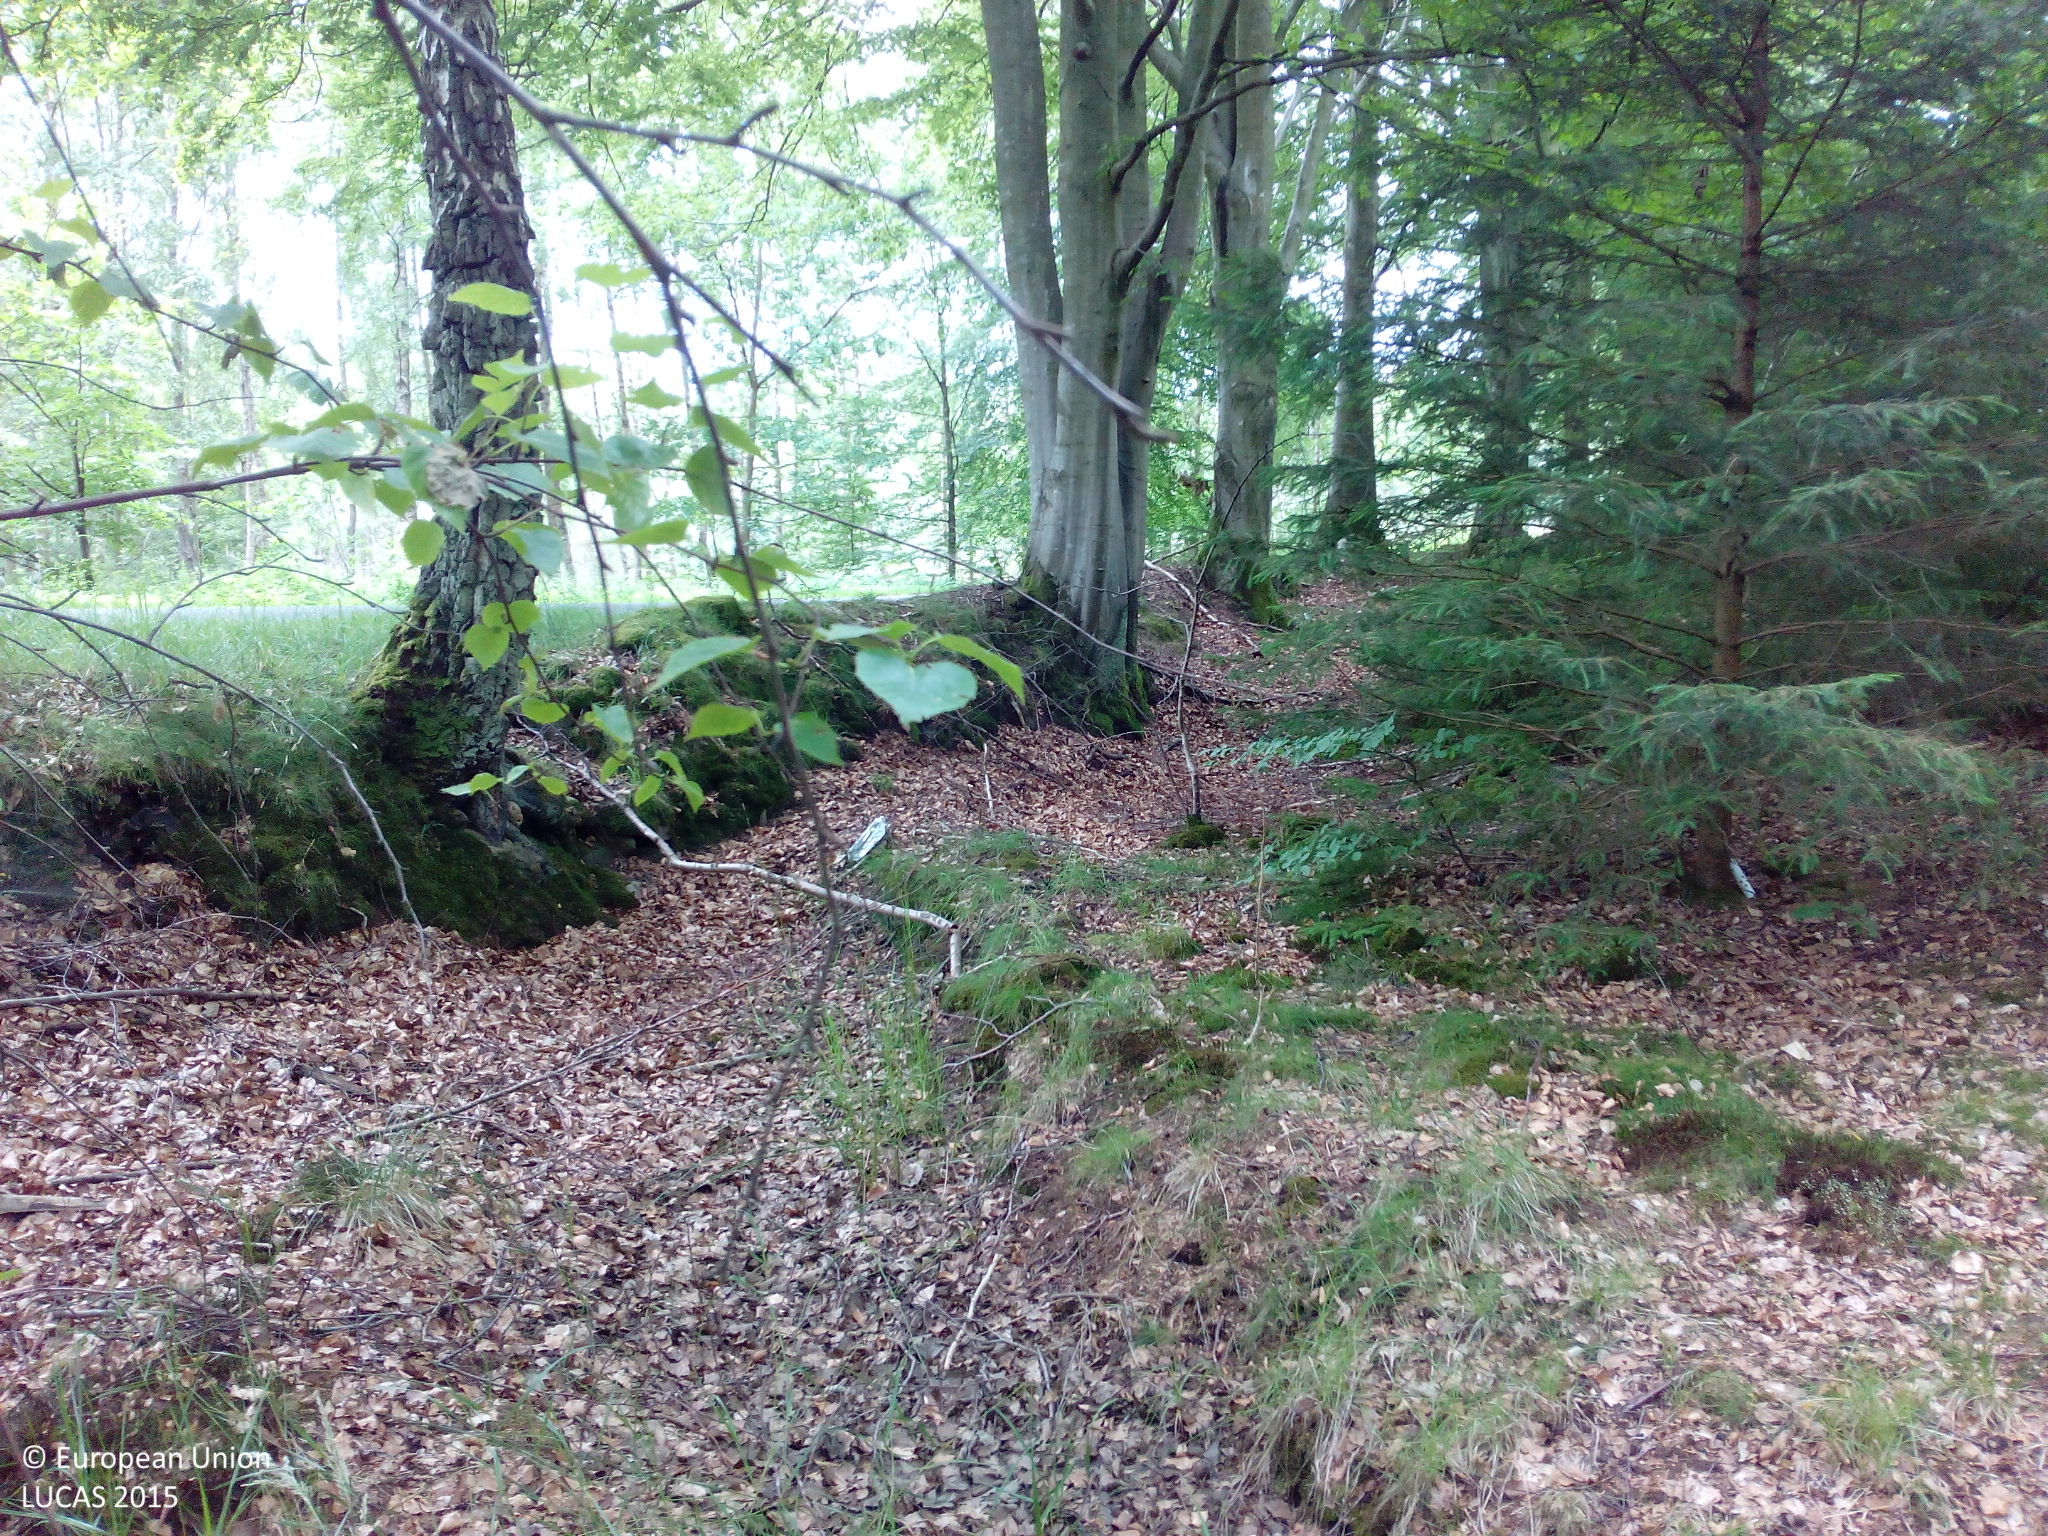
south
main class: Woodland
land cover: Broadleaved woodland
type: beech forest
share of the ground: > 75 %
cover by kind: broadleaved forest trees 75 %, coniferous forest trees 25 %
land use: Forestry
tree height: > 5 m
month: July
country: DK
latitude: 55.9690
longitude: 12.3210
